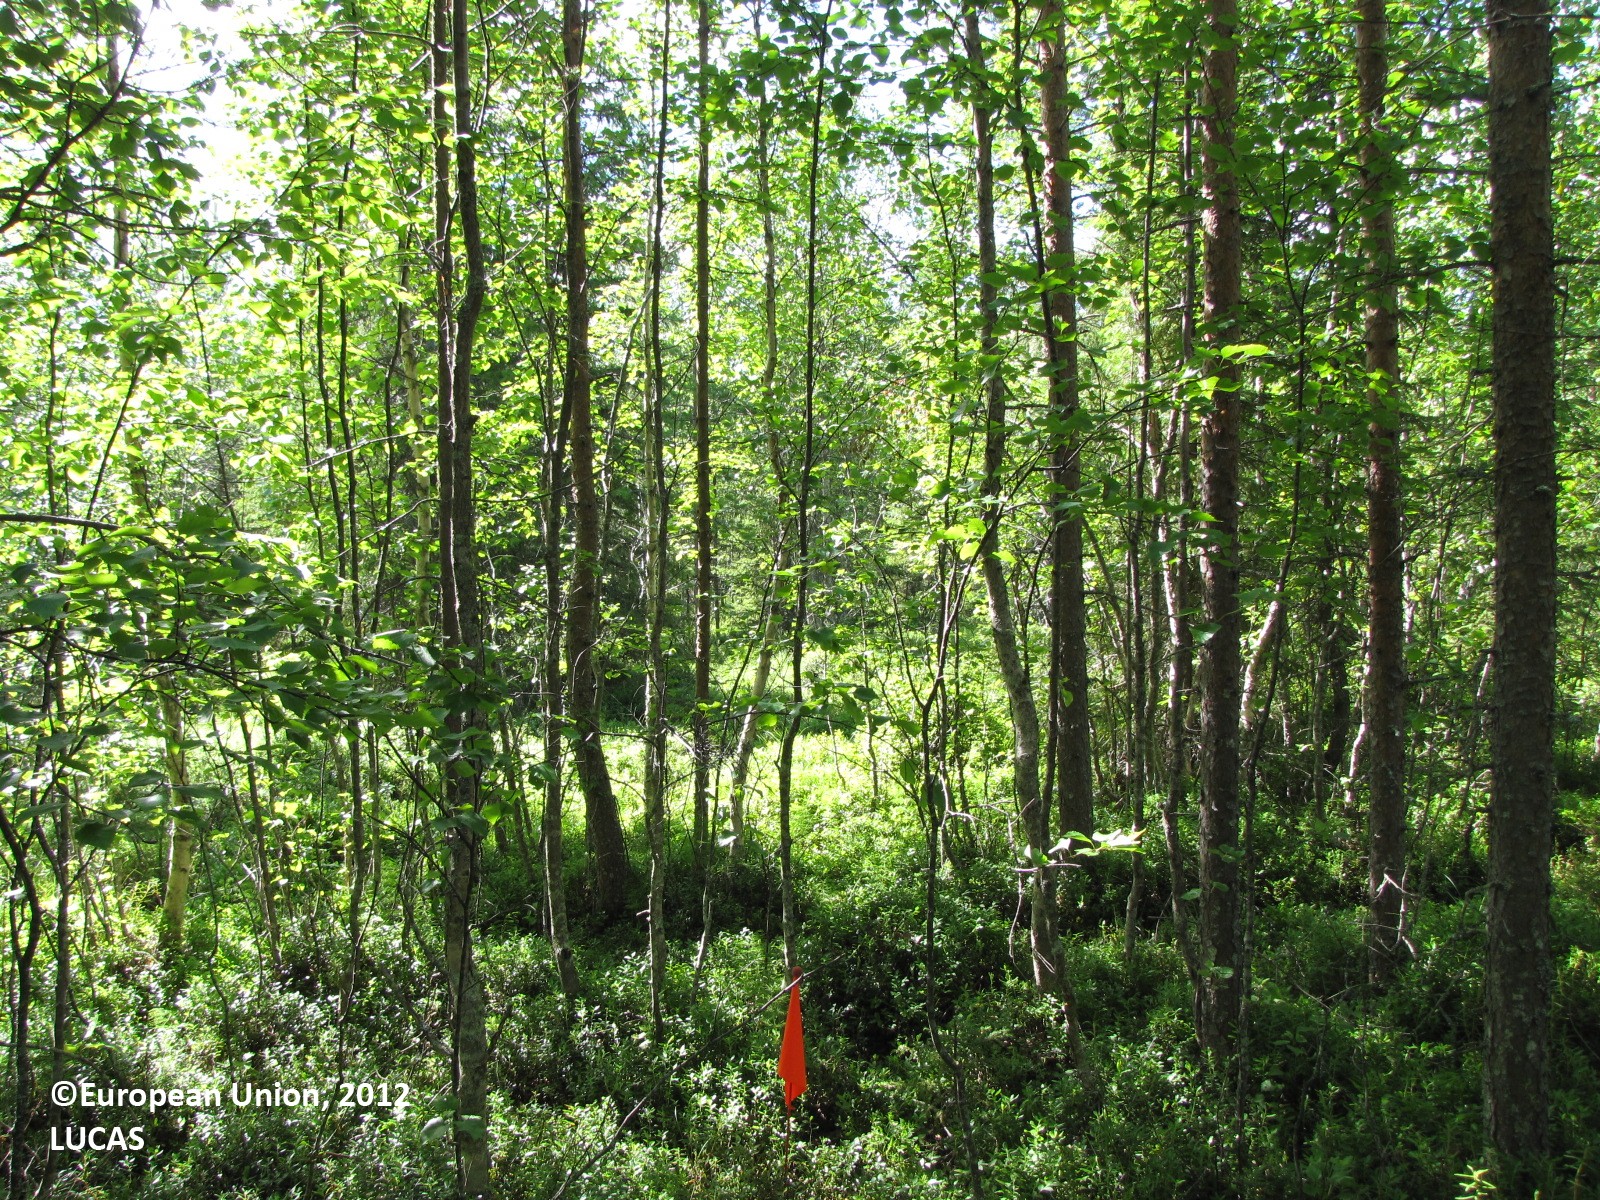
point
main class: Woodland
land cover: Other mixed woodland
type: boreal forest
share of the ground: 50 - 75 %
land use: Forestry
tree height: > 5 m
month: July
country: FI
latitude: 66.5806
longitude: 24.5878
